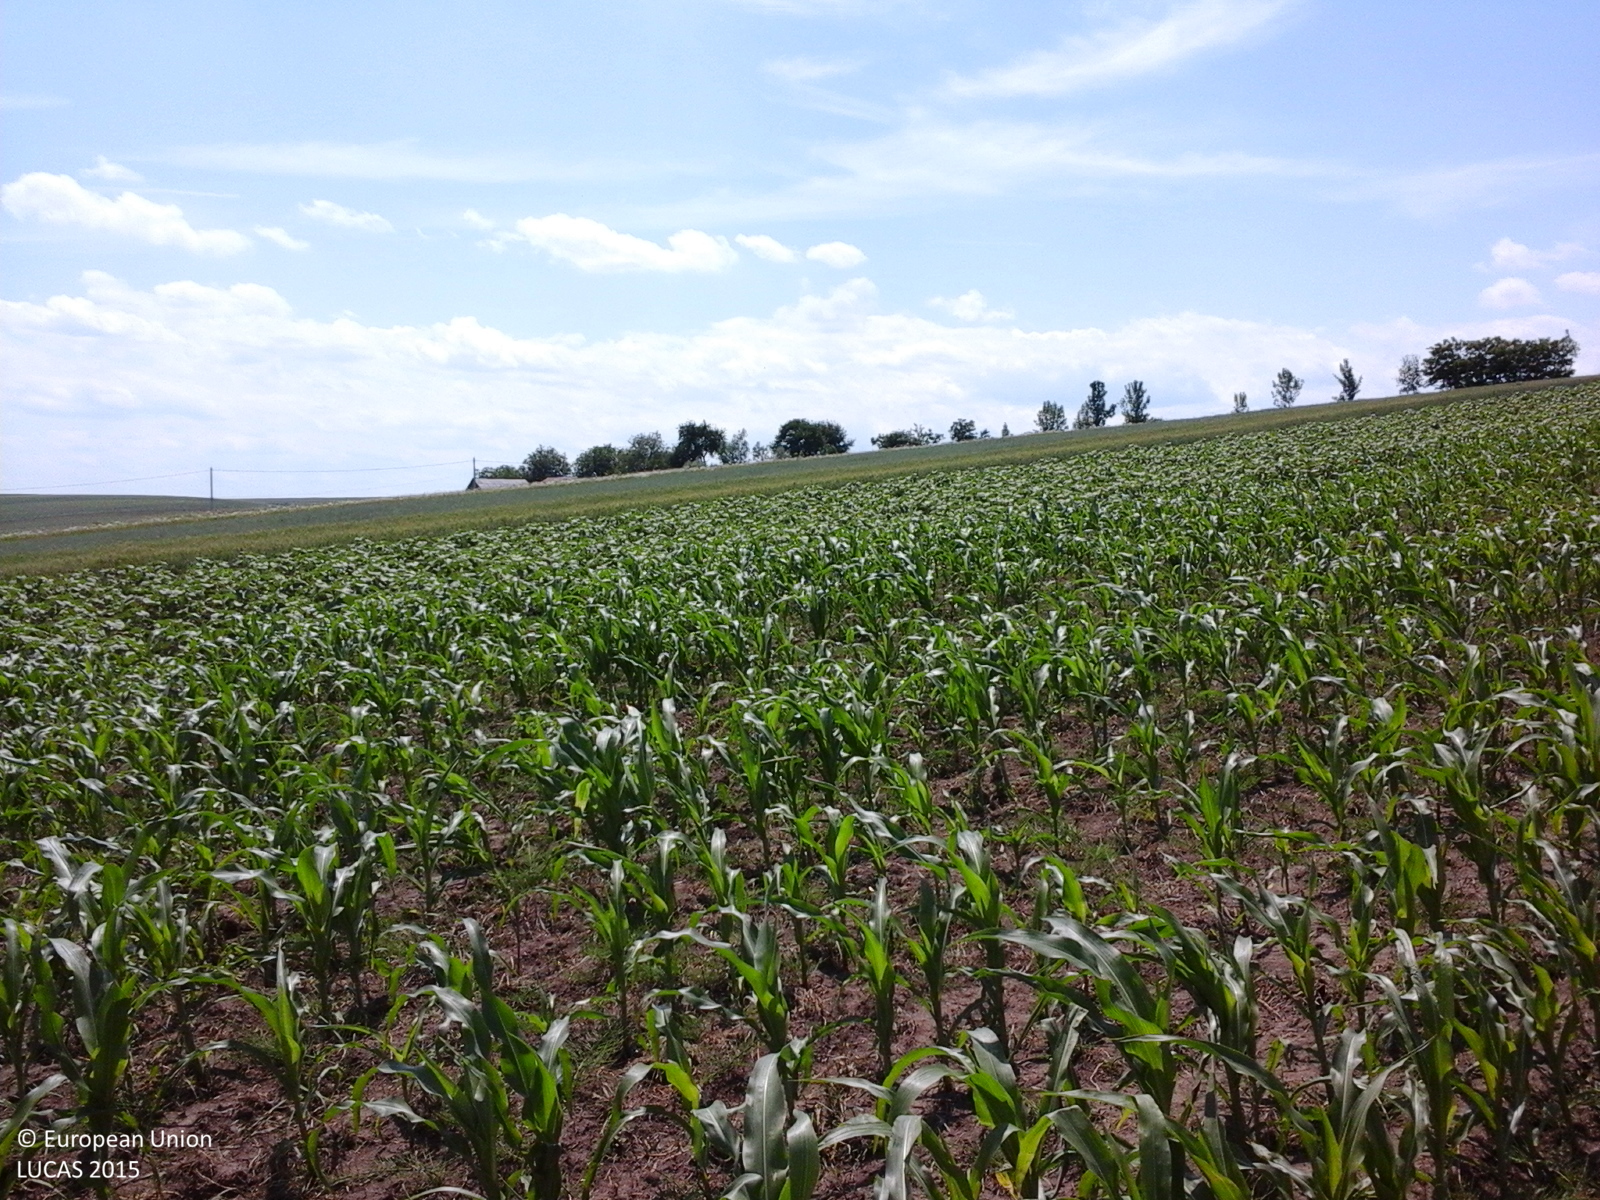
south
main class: Cropland
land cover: Maize
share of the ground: 25 - 50 %
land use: Agriculture (excluding fallow land and kitchen gardens)
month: June
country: RO
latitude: 47.5314
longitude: 26.3024
